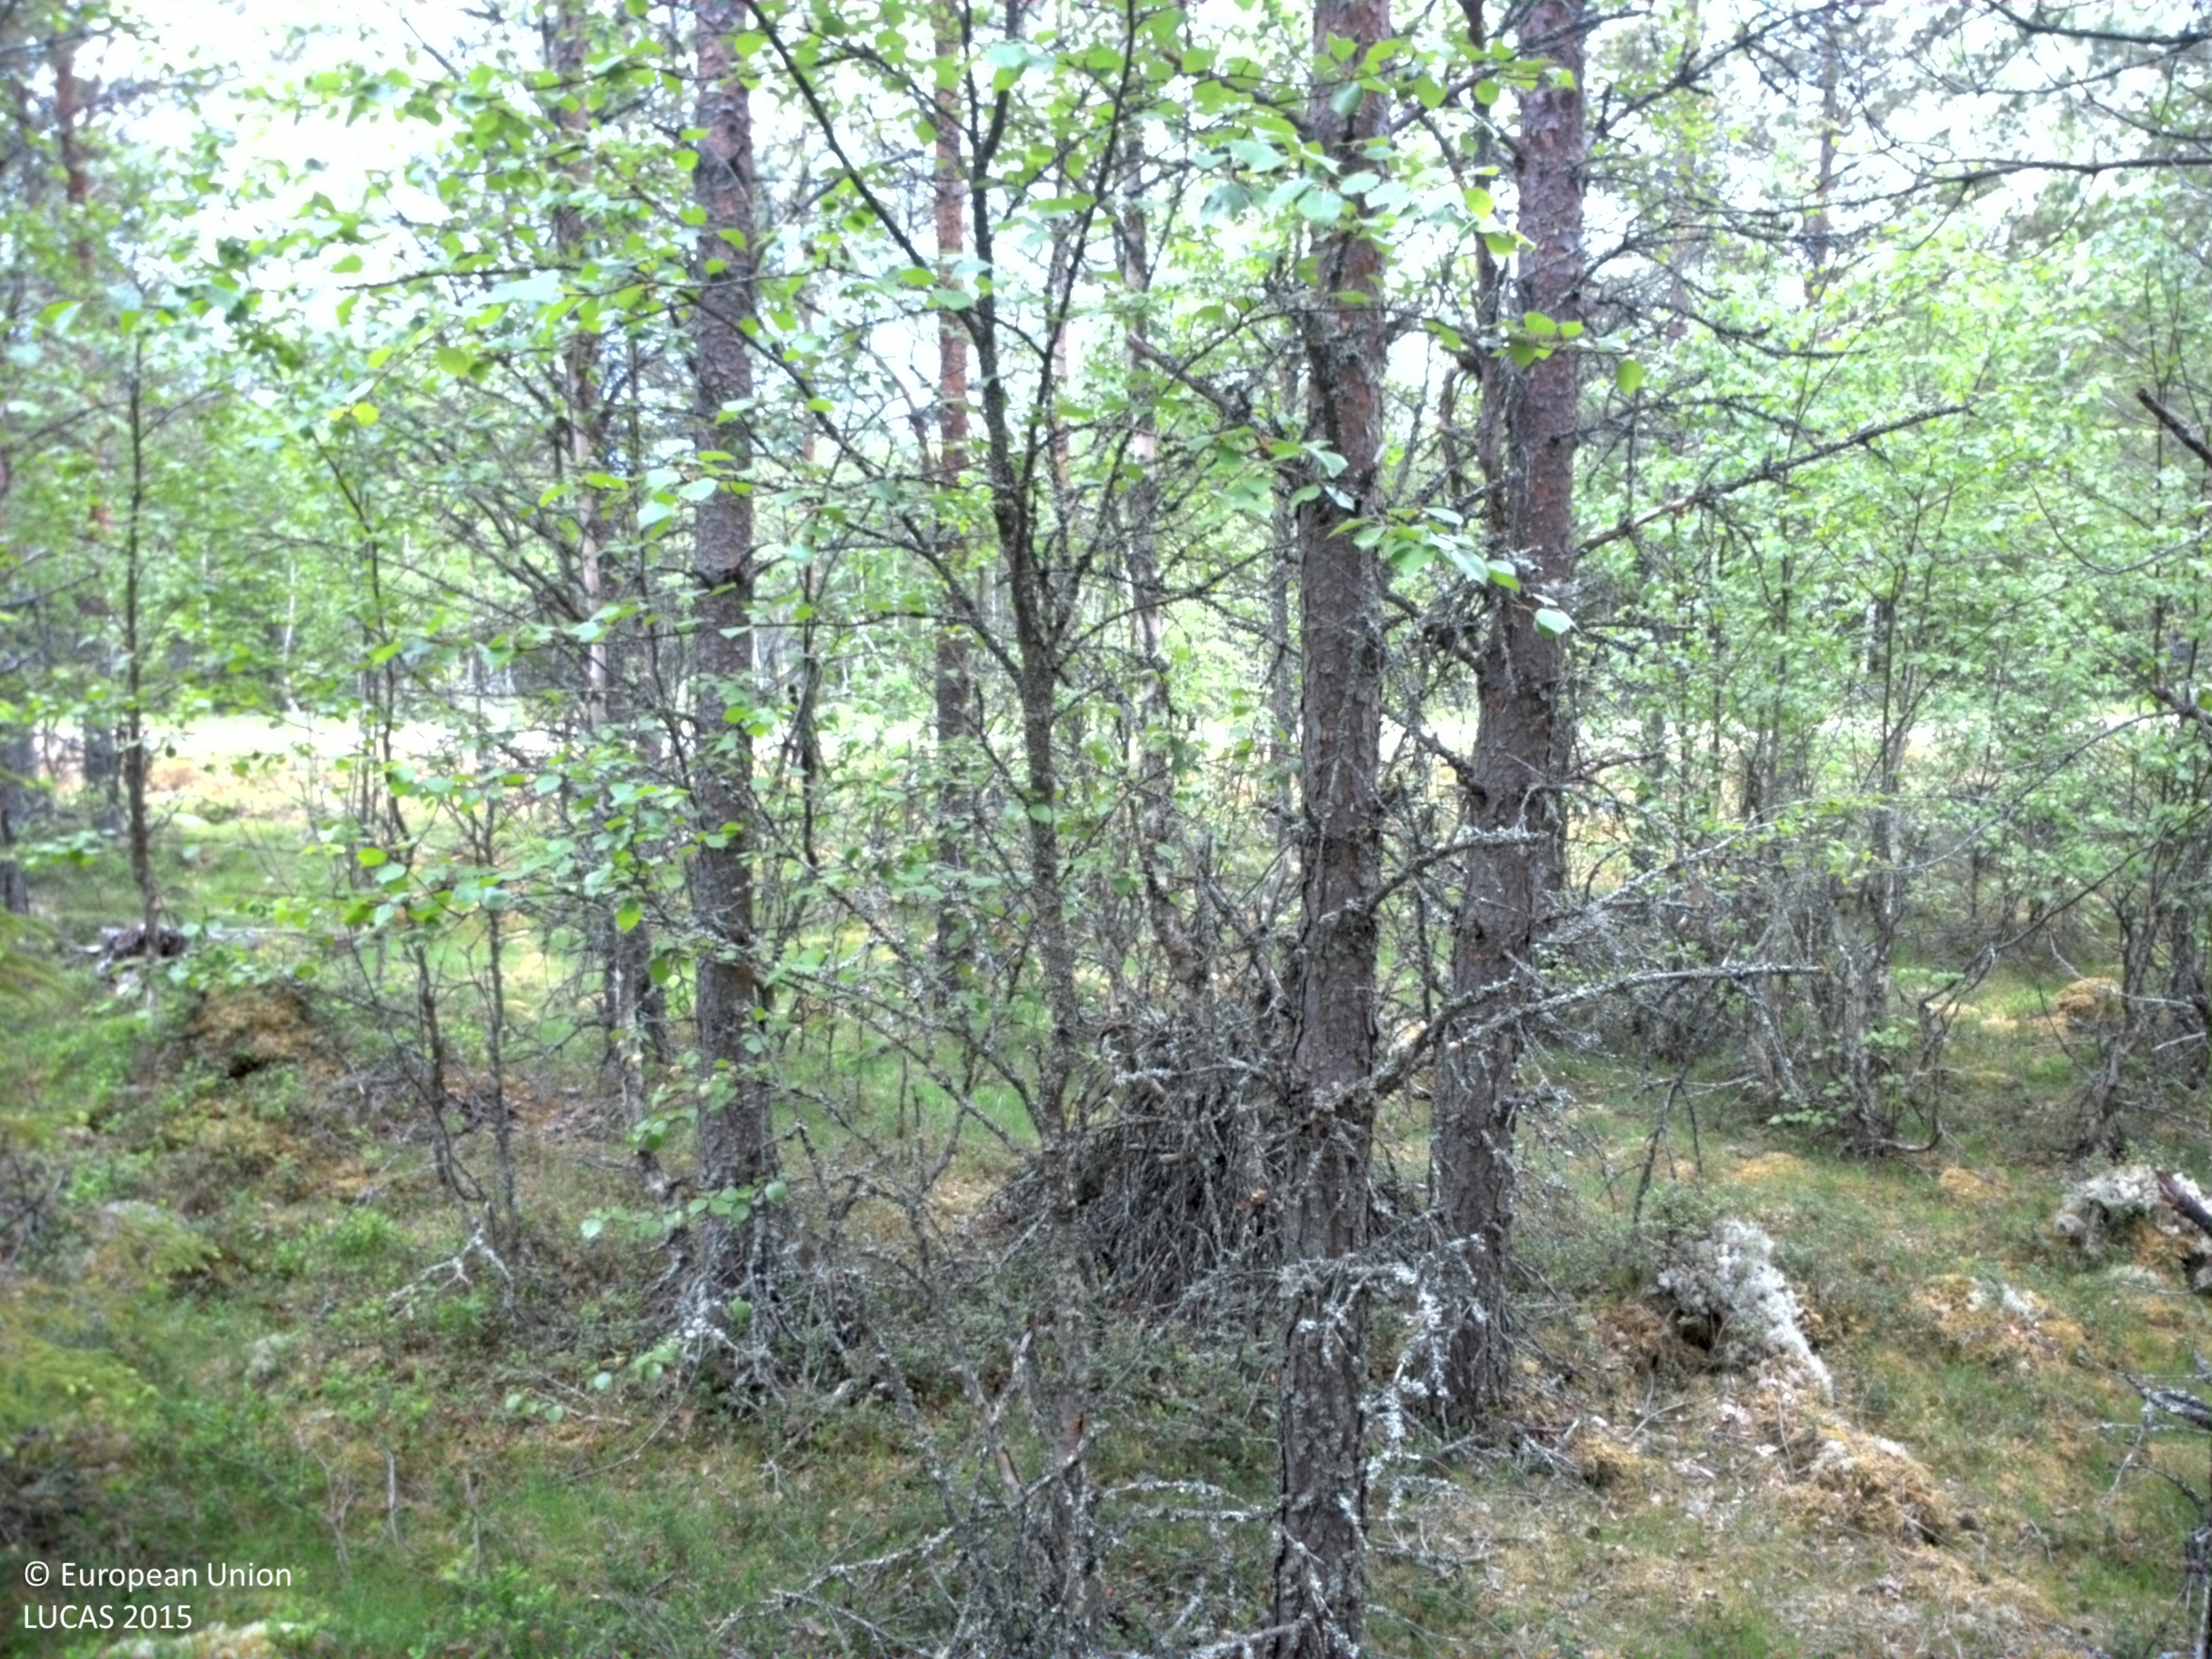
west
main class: Woodland
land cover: Pine dominated mixed woodland
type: boreal forest
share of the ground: 50 - 75 %
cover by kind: coniferous forest trees 50 %, broadleaved forest trees 25 %, lichens and mosses 15 %, herbaceous plants 10 %
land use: Forestry
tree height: > 5 m
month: June
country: SE
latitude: 61.1610
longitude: 13.6490
